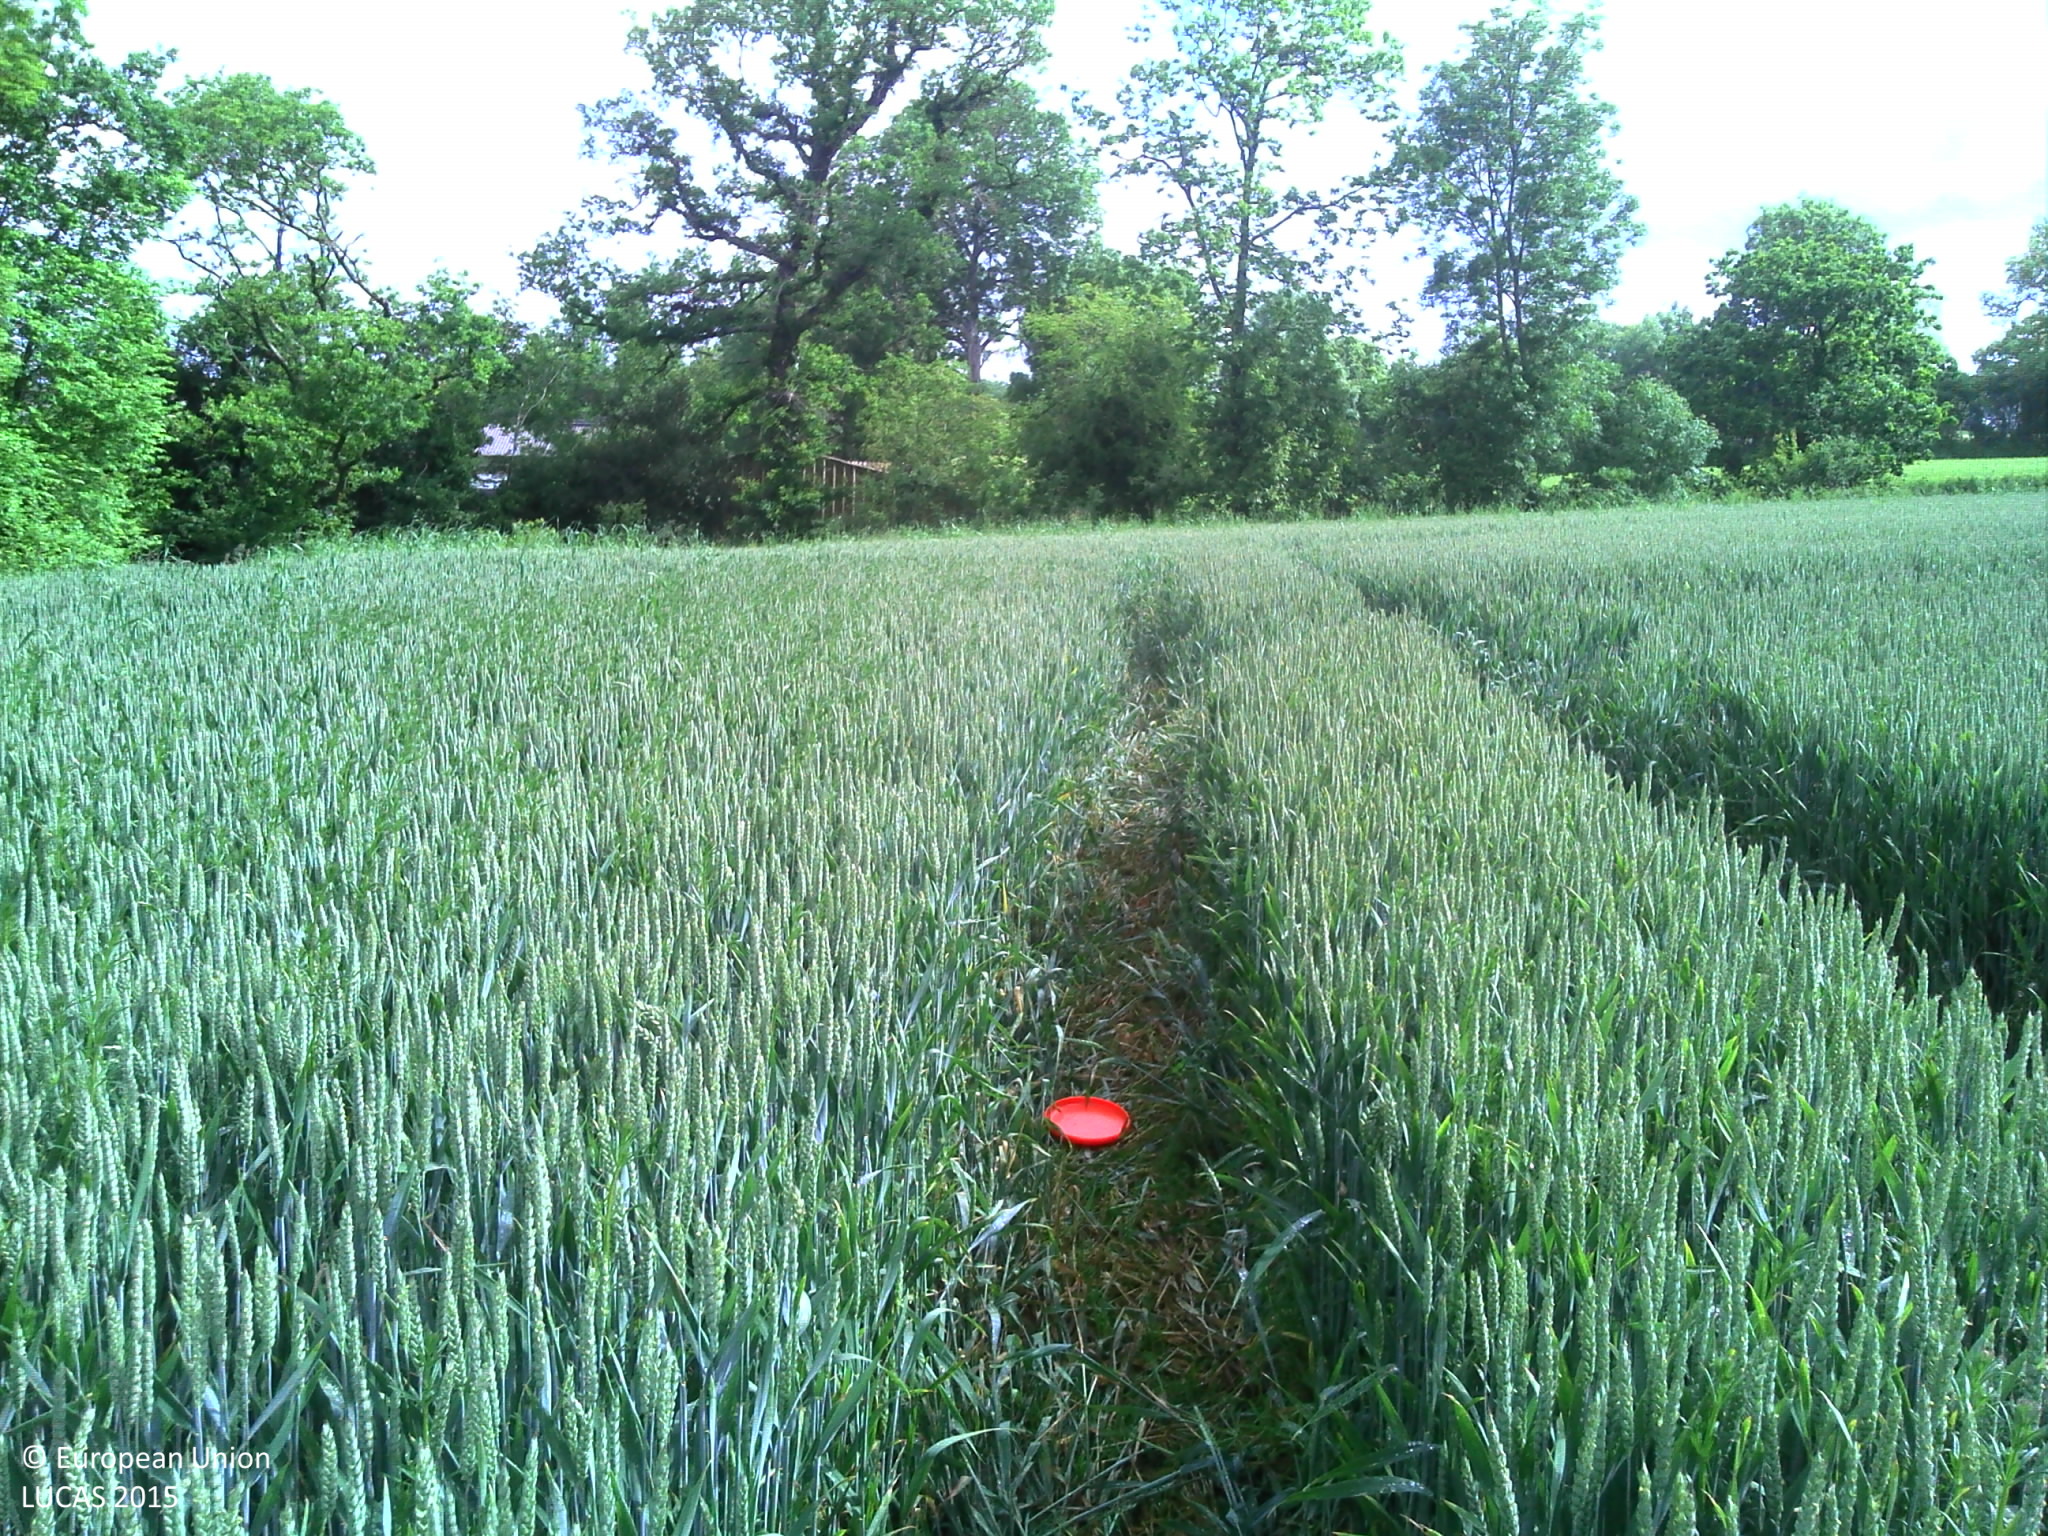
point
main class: Cropland
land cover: Common wheat
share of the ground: > 75 %
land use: Agriculture (excluding fallow land and kitchen gardens)
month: June
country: FR
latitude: 49.5577
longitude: -1.7343
